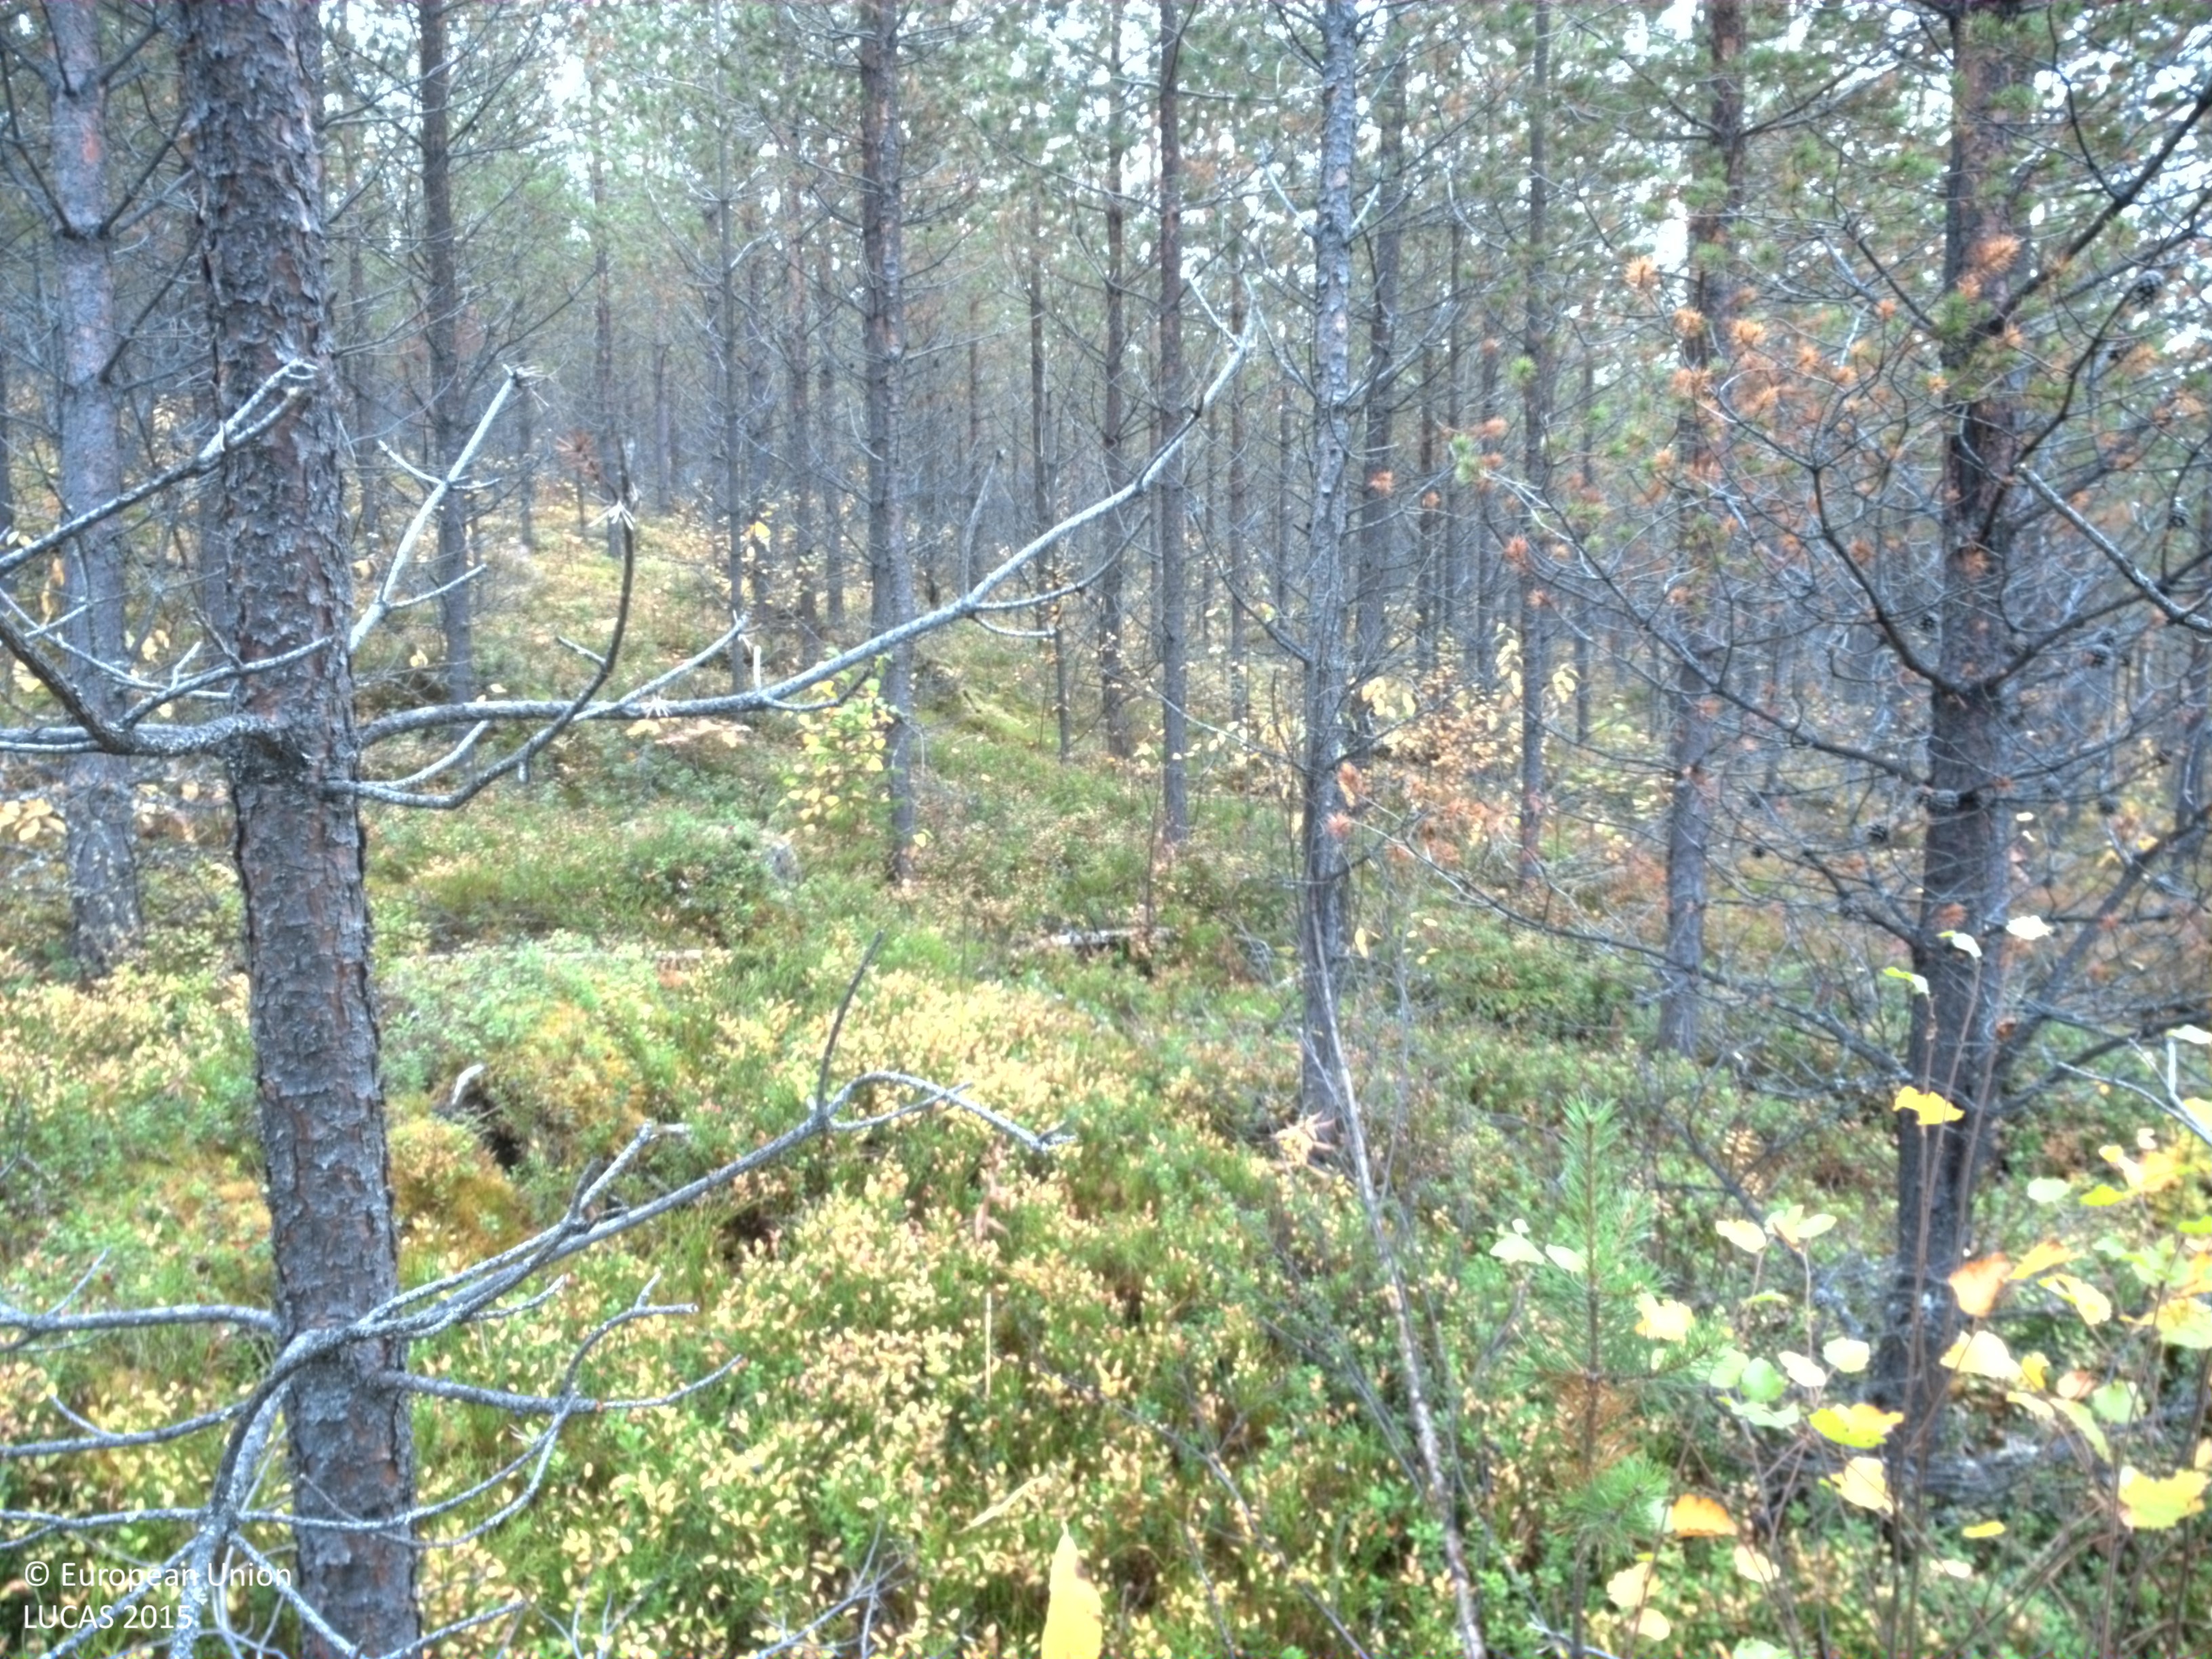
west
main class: Woodland
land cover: Pine dominated coniferous woodland
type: boreal forest
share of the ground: 25 - 50 %
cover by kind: coniferous forest trees 40 %, shrubs 40 %, lichens and mosses 15 %, broadleaved forest trees 5 %
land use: Forestry
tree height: > 5 m
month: September
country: SE
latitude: 64.8984
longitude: 17.7600
